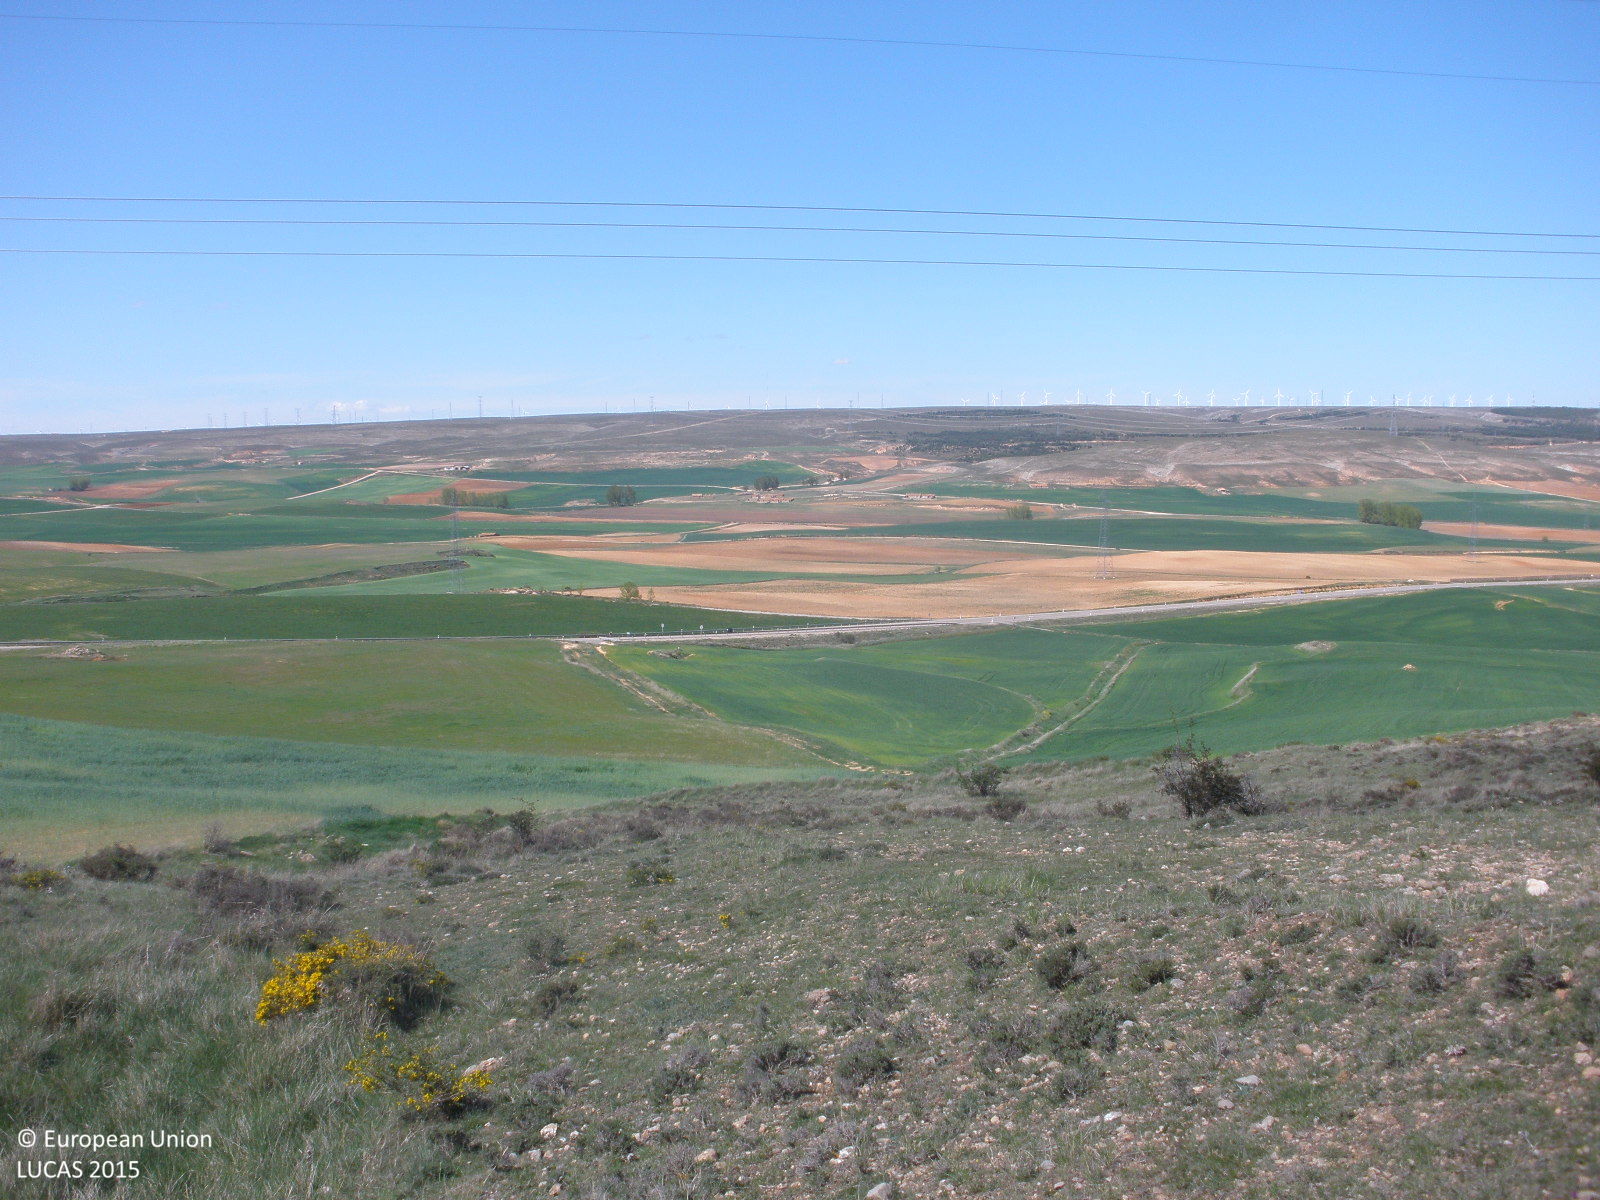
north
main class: Grassland
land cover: Grassland without tree/shrub cover
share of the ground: > 75 %
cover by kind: herbaceous plants 100 %
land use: Semi-natural and natural areas not in use
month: May
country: ES
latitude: 40.7167
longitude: -0.8920
